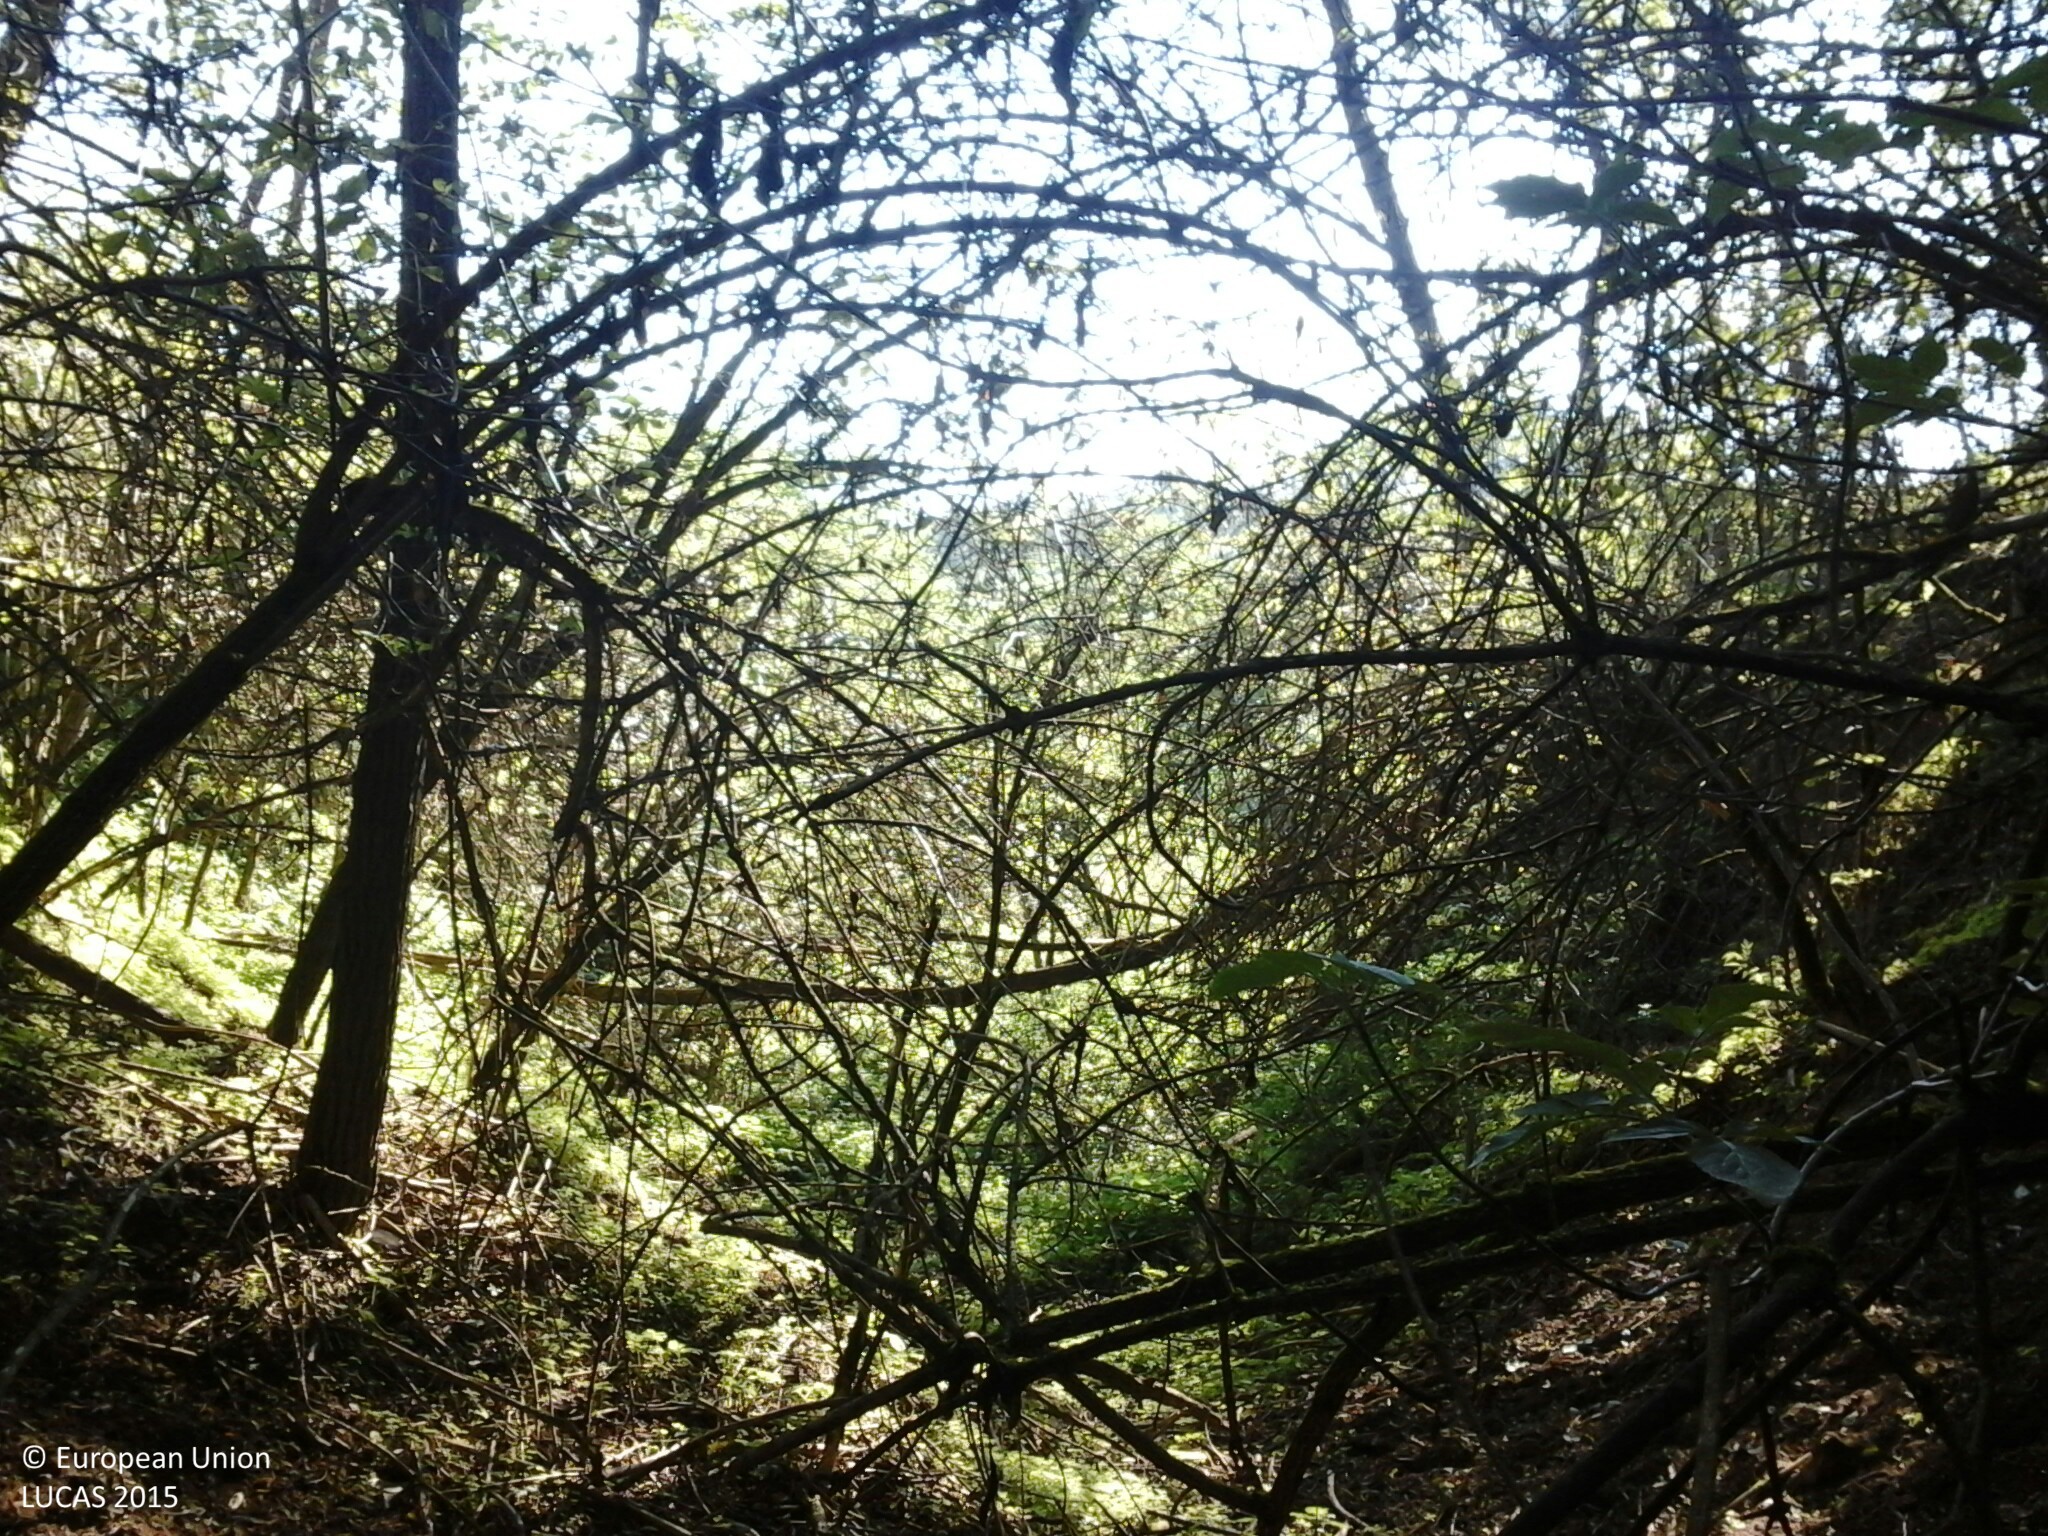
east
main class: Woodland
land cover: Broadleaved woodland
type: mesophytic deciduous forest
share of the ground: > 75 %
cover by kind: broadleaved forest trees 90 %, shrubs 5 %, herbaceous plants 5 %
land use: Forestry
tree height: > 5 m
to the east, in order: Broadleaved woodland; Shrubland with sparse tree cover; Grassland without tree/shrub cover
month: September
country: HU
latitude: 48.1317
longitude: 19.9849
